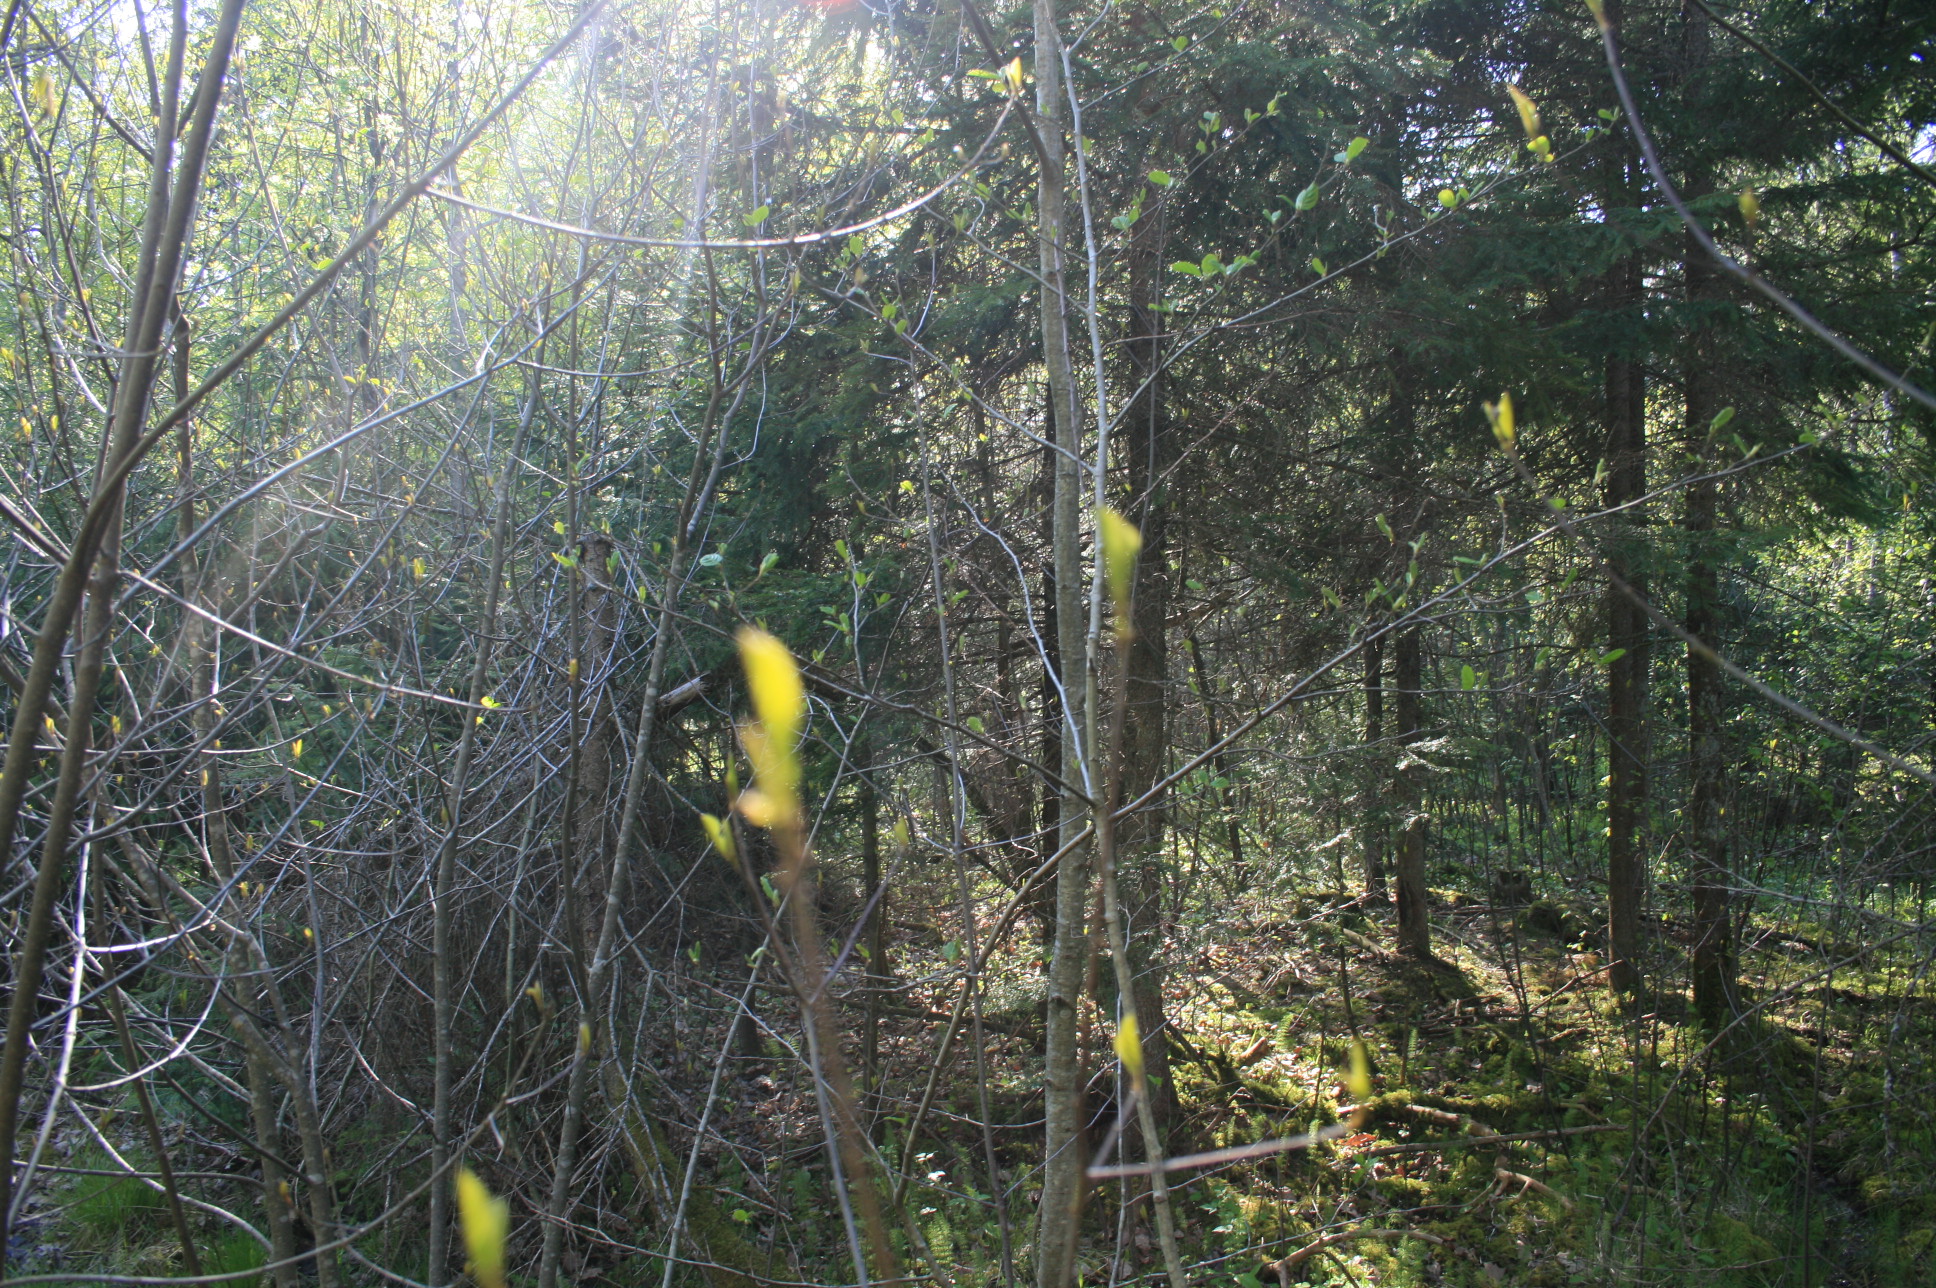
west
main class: Woodland
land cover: Other mixed woodland
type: hemiboreal forest and nemoral coniferous forest and mixed broadleaved-coniferous forest
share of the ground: > 75 %
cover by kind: coniferous forest trees 70 %, broadleaved forest trees 25 %, lichens and mosses 5 %
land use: Forestry
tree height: > 5 m
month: May
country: LT
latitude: 55.9805
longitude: 21.4708
